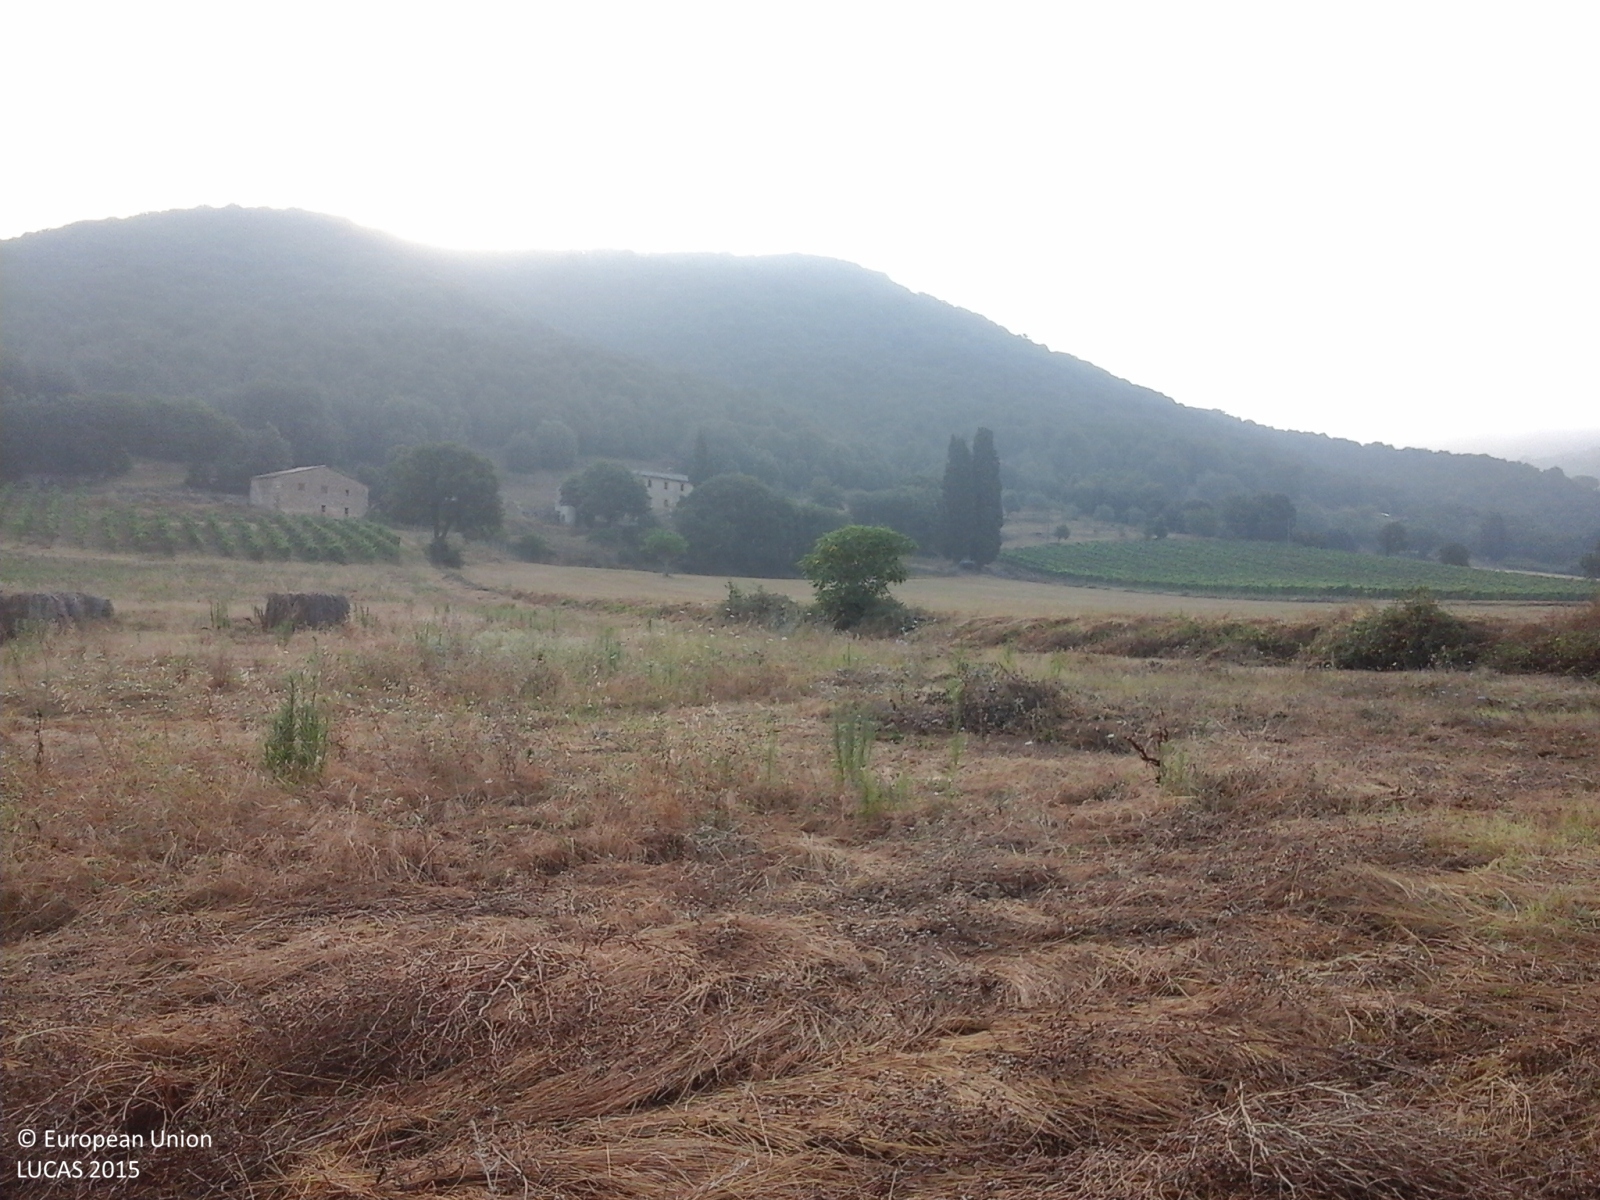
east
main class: Grassland
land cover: Grassland without tree/shrub cover
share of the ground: > 75 %
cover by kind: herbaceous plants 100 %
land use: Agriculture (excluding fallow land and kitchen gardens)
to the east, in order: Grassland without tree/shrub cover; Ditches and canals; Durum wheat; Broadleaved woodland
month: July
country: IT
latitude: 43.2796
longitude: 11.1427
